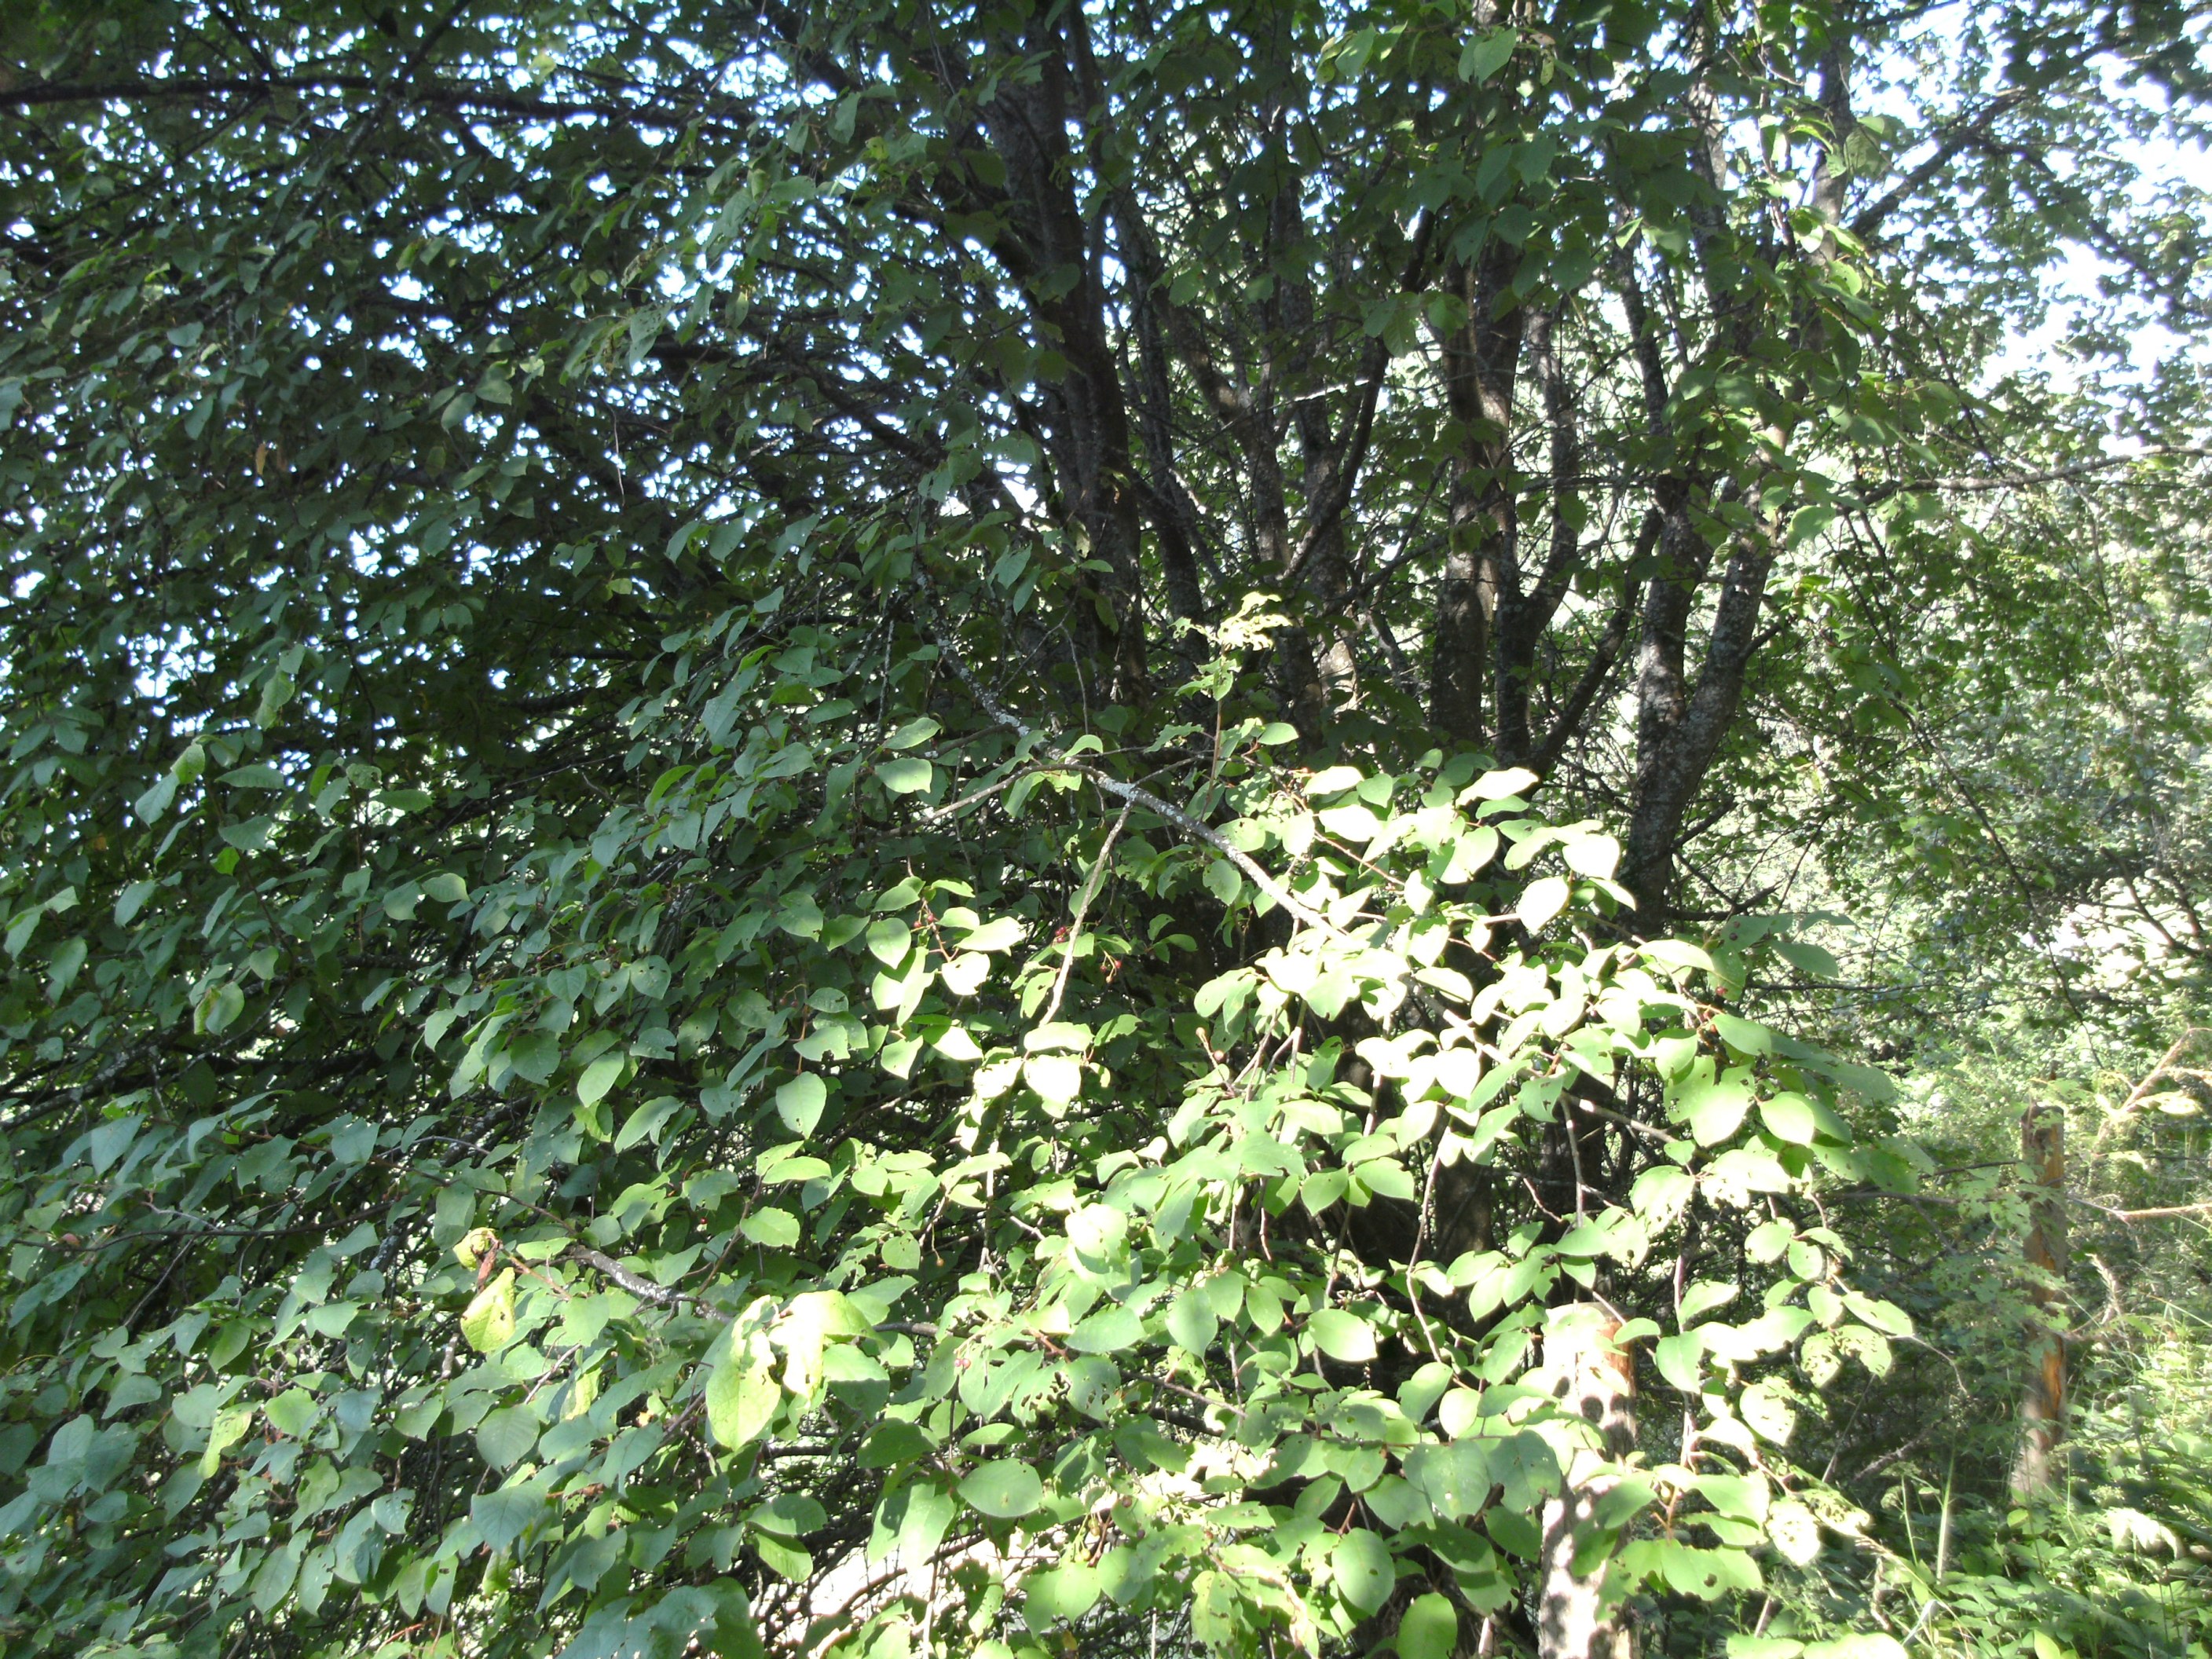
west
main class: Grassland
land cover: Grassland without tree/shrub cover
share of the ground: > 75 %
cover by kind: herbaceous plants 100 %
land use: Agriculture (excluding fallow land and kitchen gardens)
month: July
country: AT
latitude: 46.8157
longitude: 14.9133
